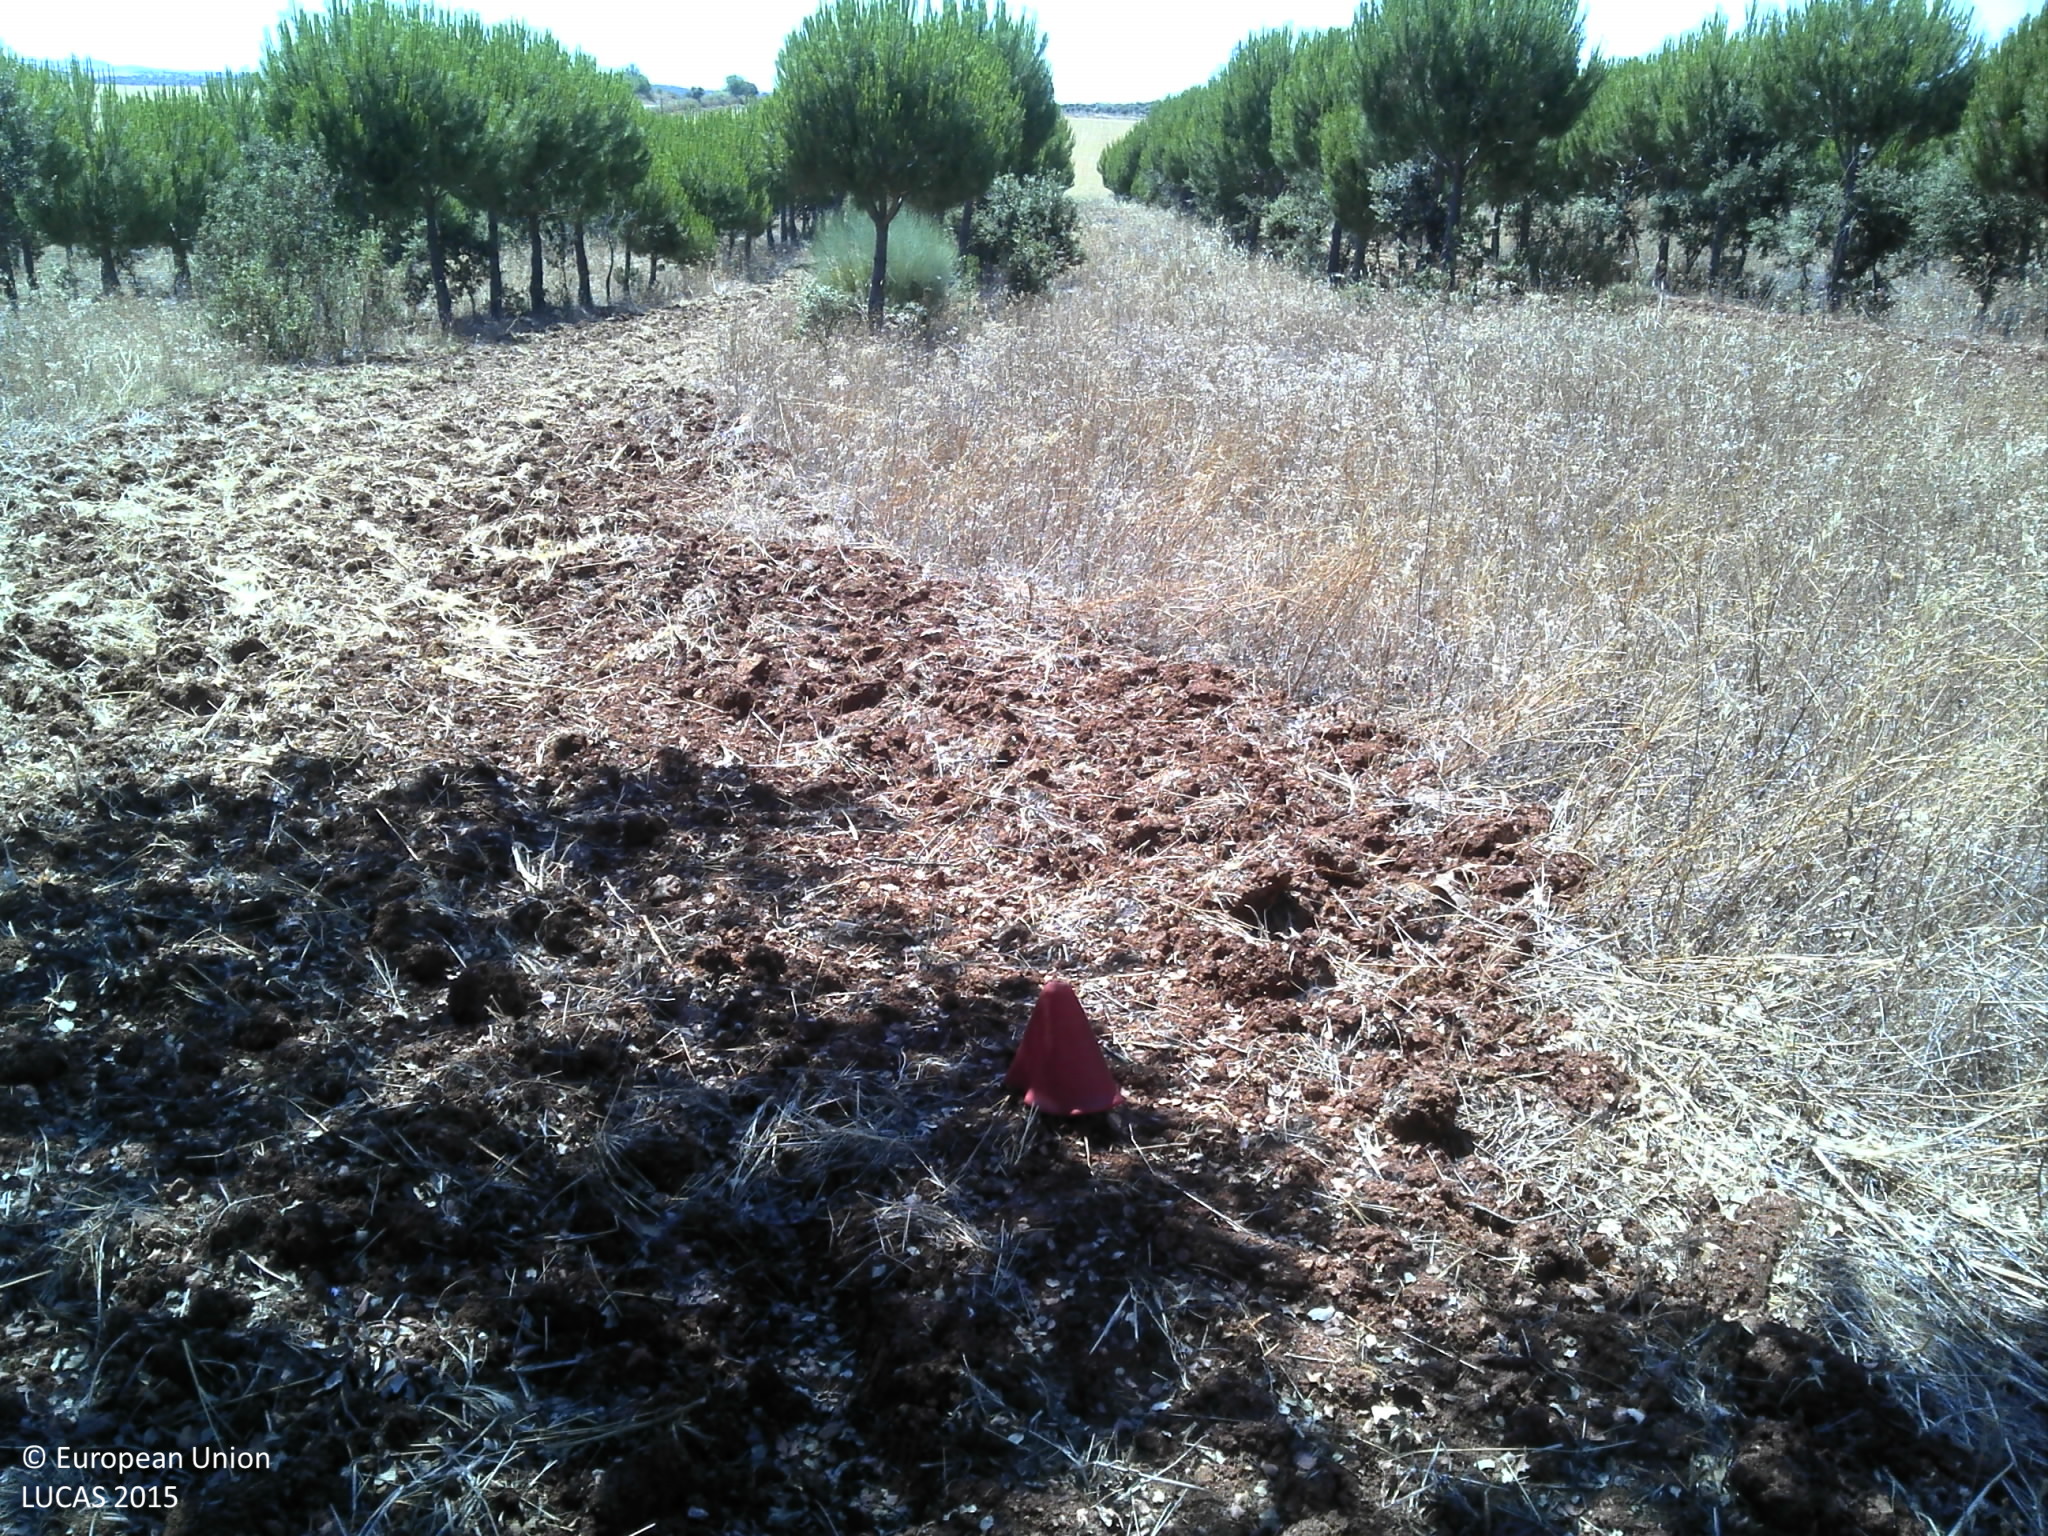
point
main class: Woodland
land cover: Pine dominated mixed woodland
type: coniferous forest of the mediterranean region
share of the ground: 50 - 75 %
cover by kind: coniferous forest trees 50 %, broadleaved forest trees 20 %, herbaceous plants 15 %, unconsolidated bare surface 15 %
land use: Forestry
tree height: < 5 m
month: July
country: PT
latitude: 38.1359
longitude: -7.3488
